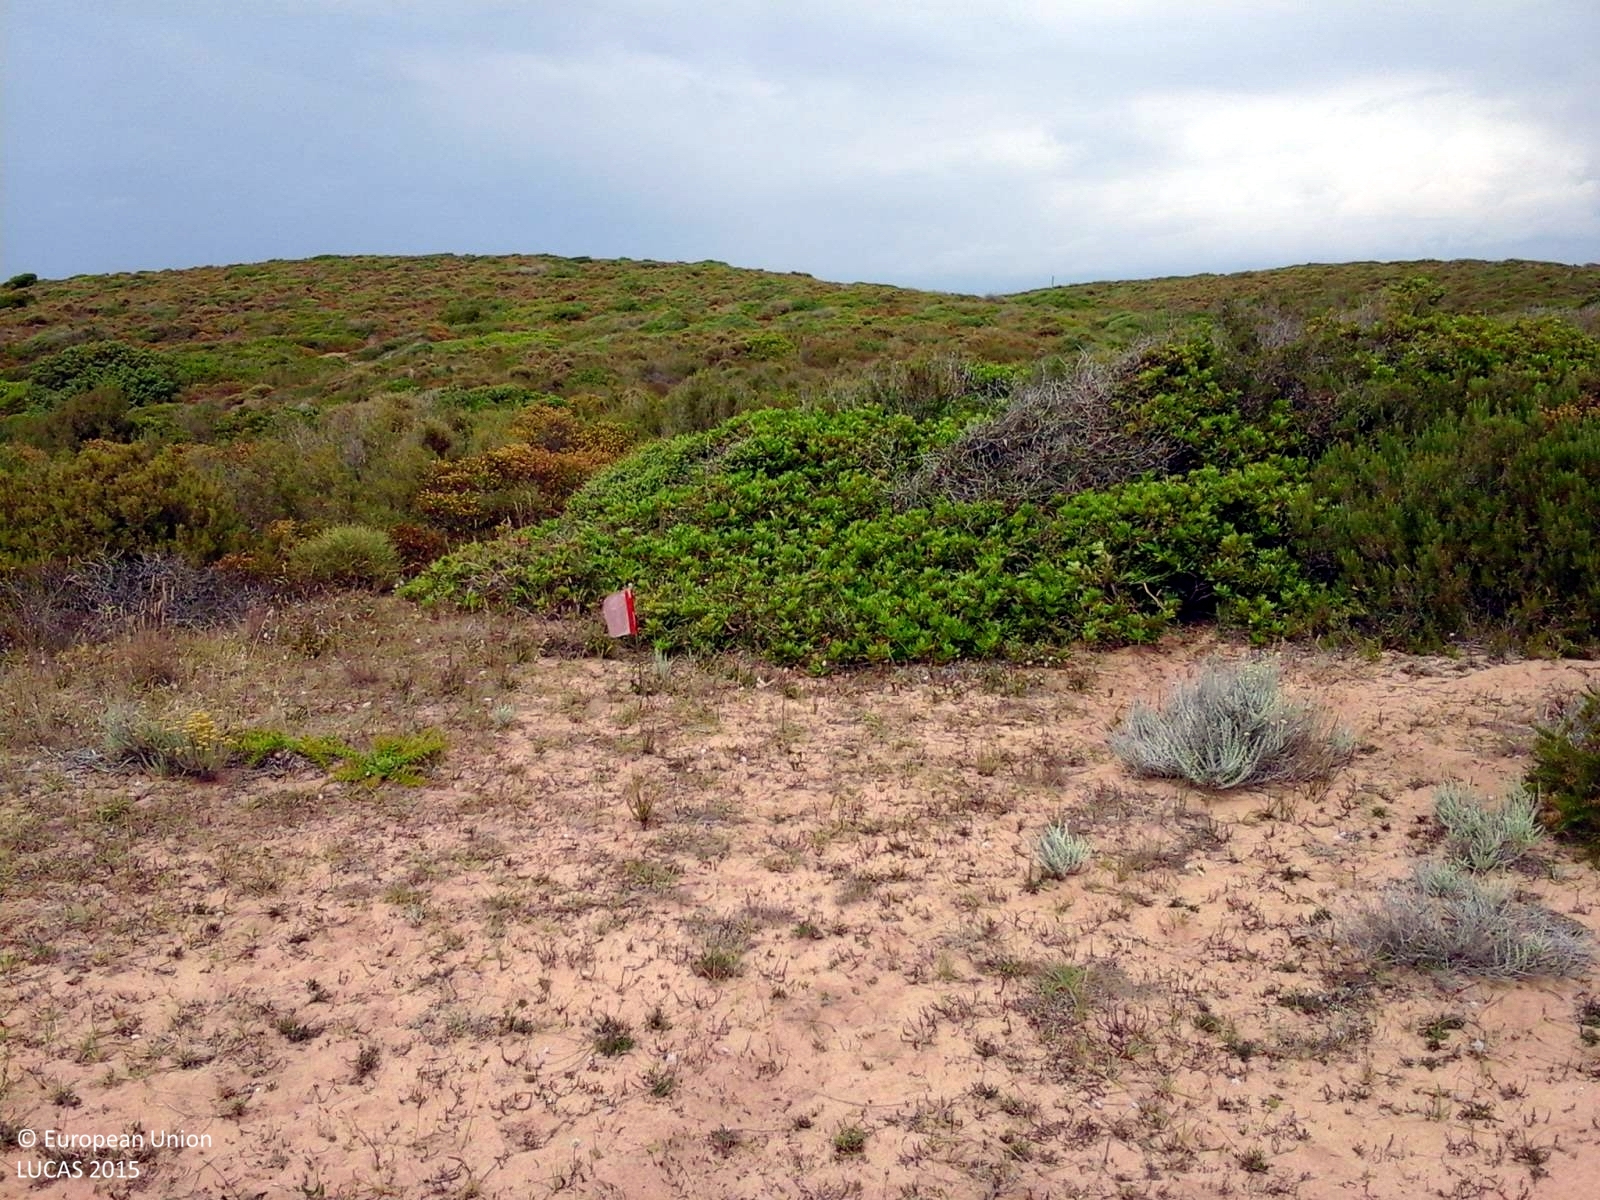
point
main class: Shrubland
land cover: Shrubland without tree cover
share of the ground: > 75 %
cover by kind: shrubs 70 %, herbaceous plants 30 %
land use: Semi-natural and natural areas not in use
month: June
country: IT
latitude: 39.6938
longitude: 8.4579
